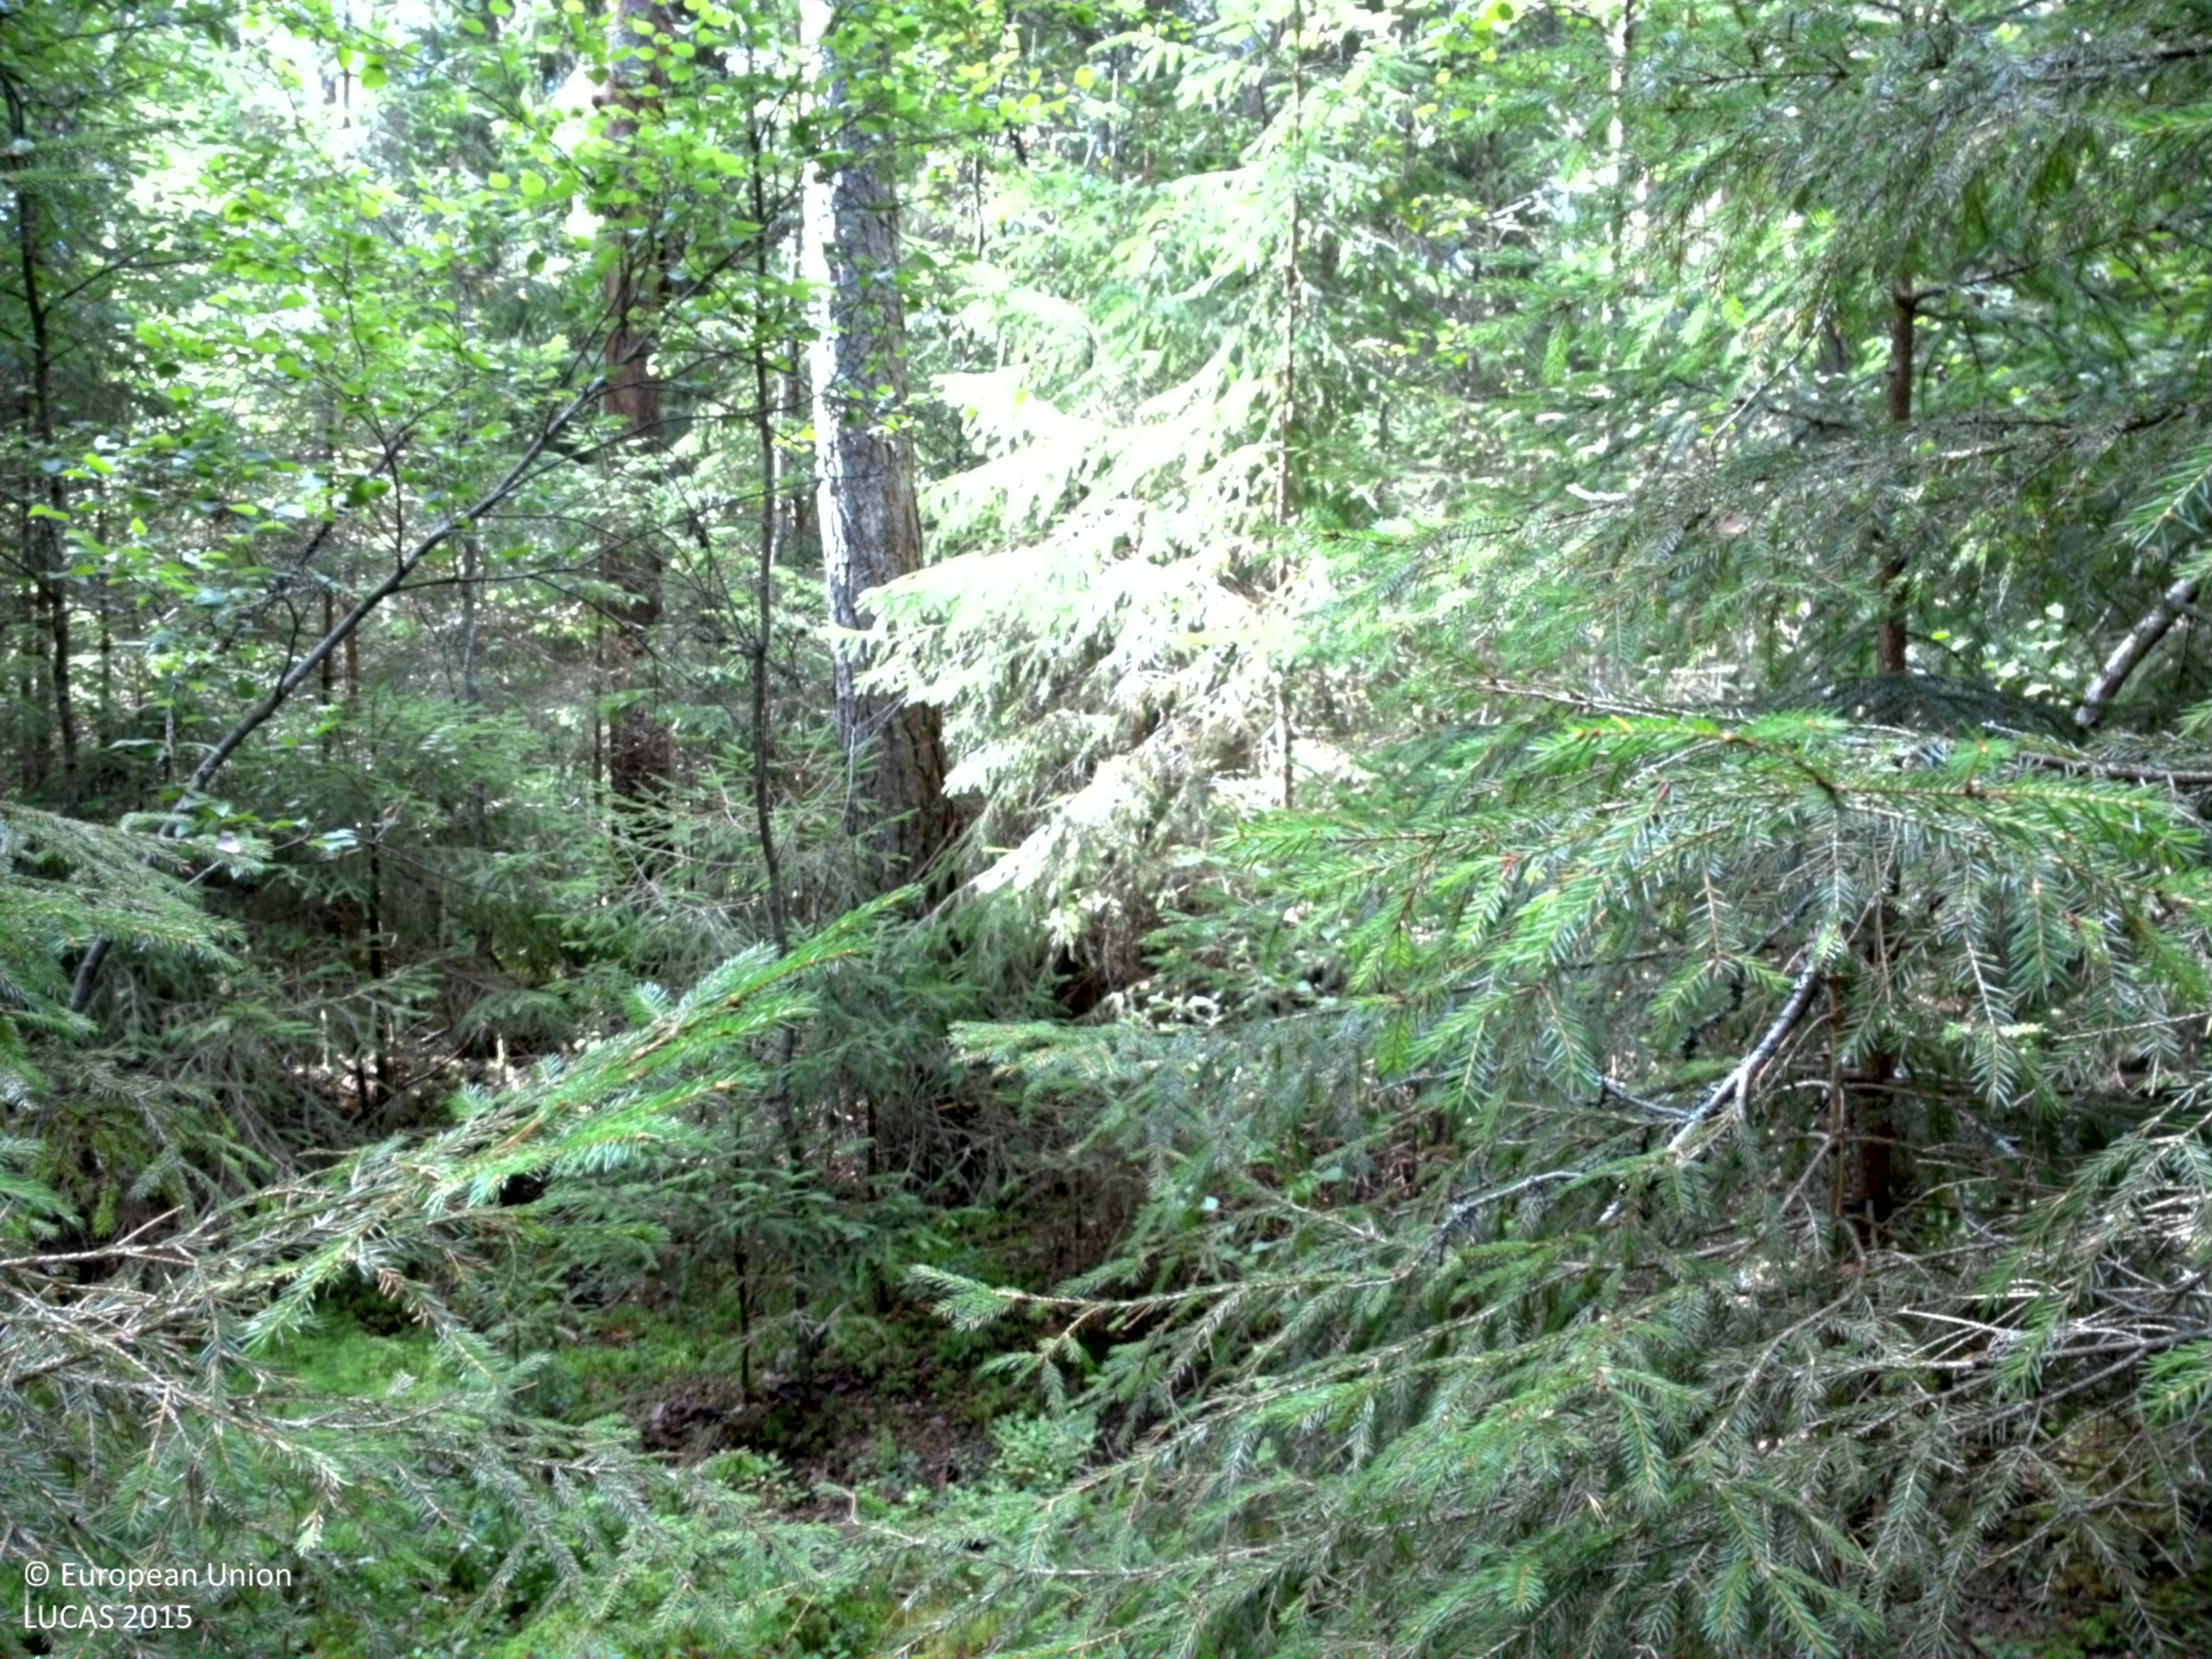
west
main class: Woodland
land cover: Other coniferous woodland
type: boreal forest
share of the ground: > 75 %
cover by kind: coniferous forest trees 75 %, shrubs 10 %, lichens and mosses 10 %, broadleaved forest trees 5 %
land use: Forestry
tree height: > 5 m
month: August
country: SE
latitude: 59.9850
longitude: 16.3168
